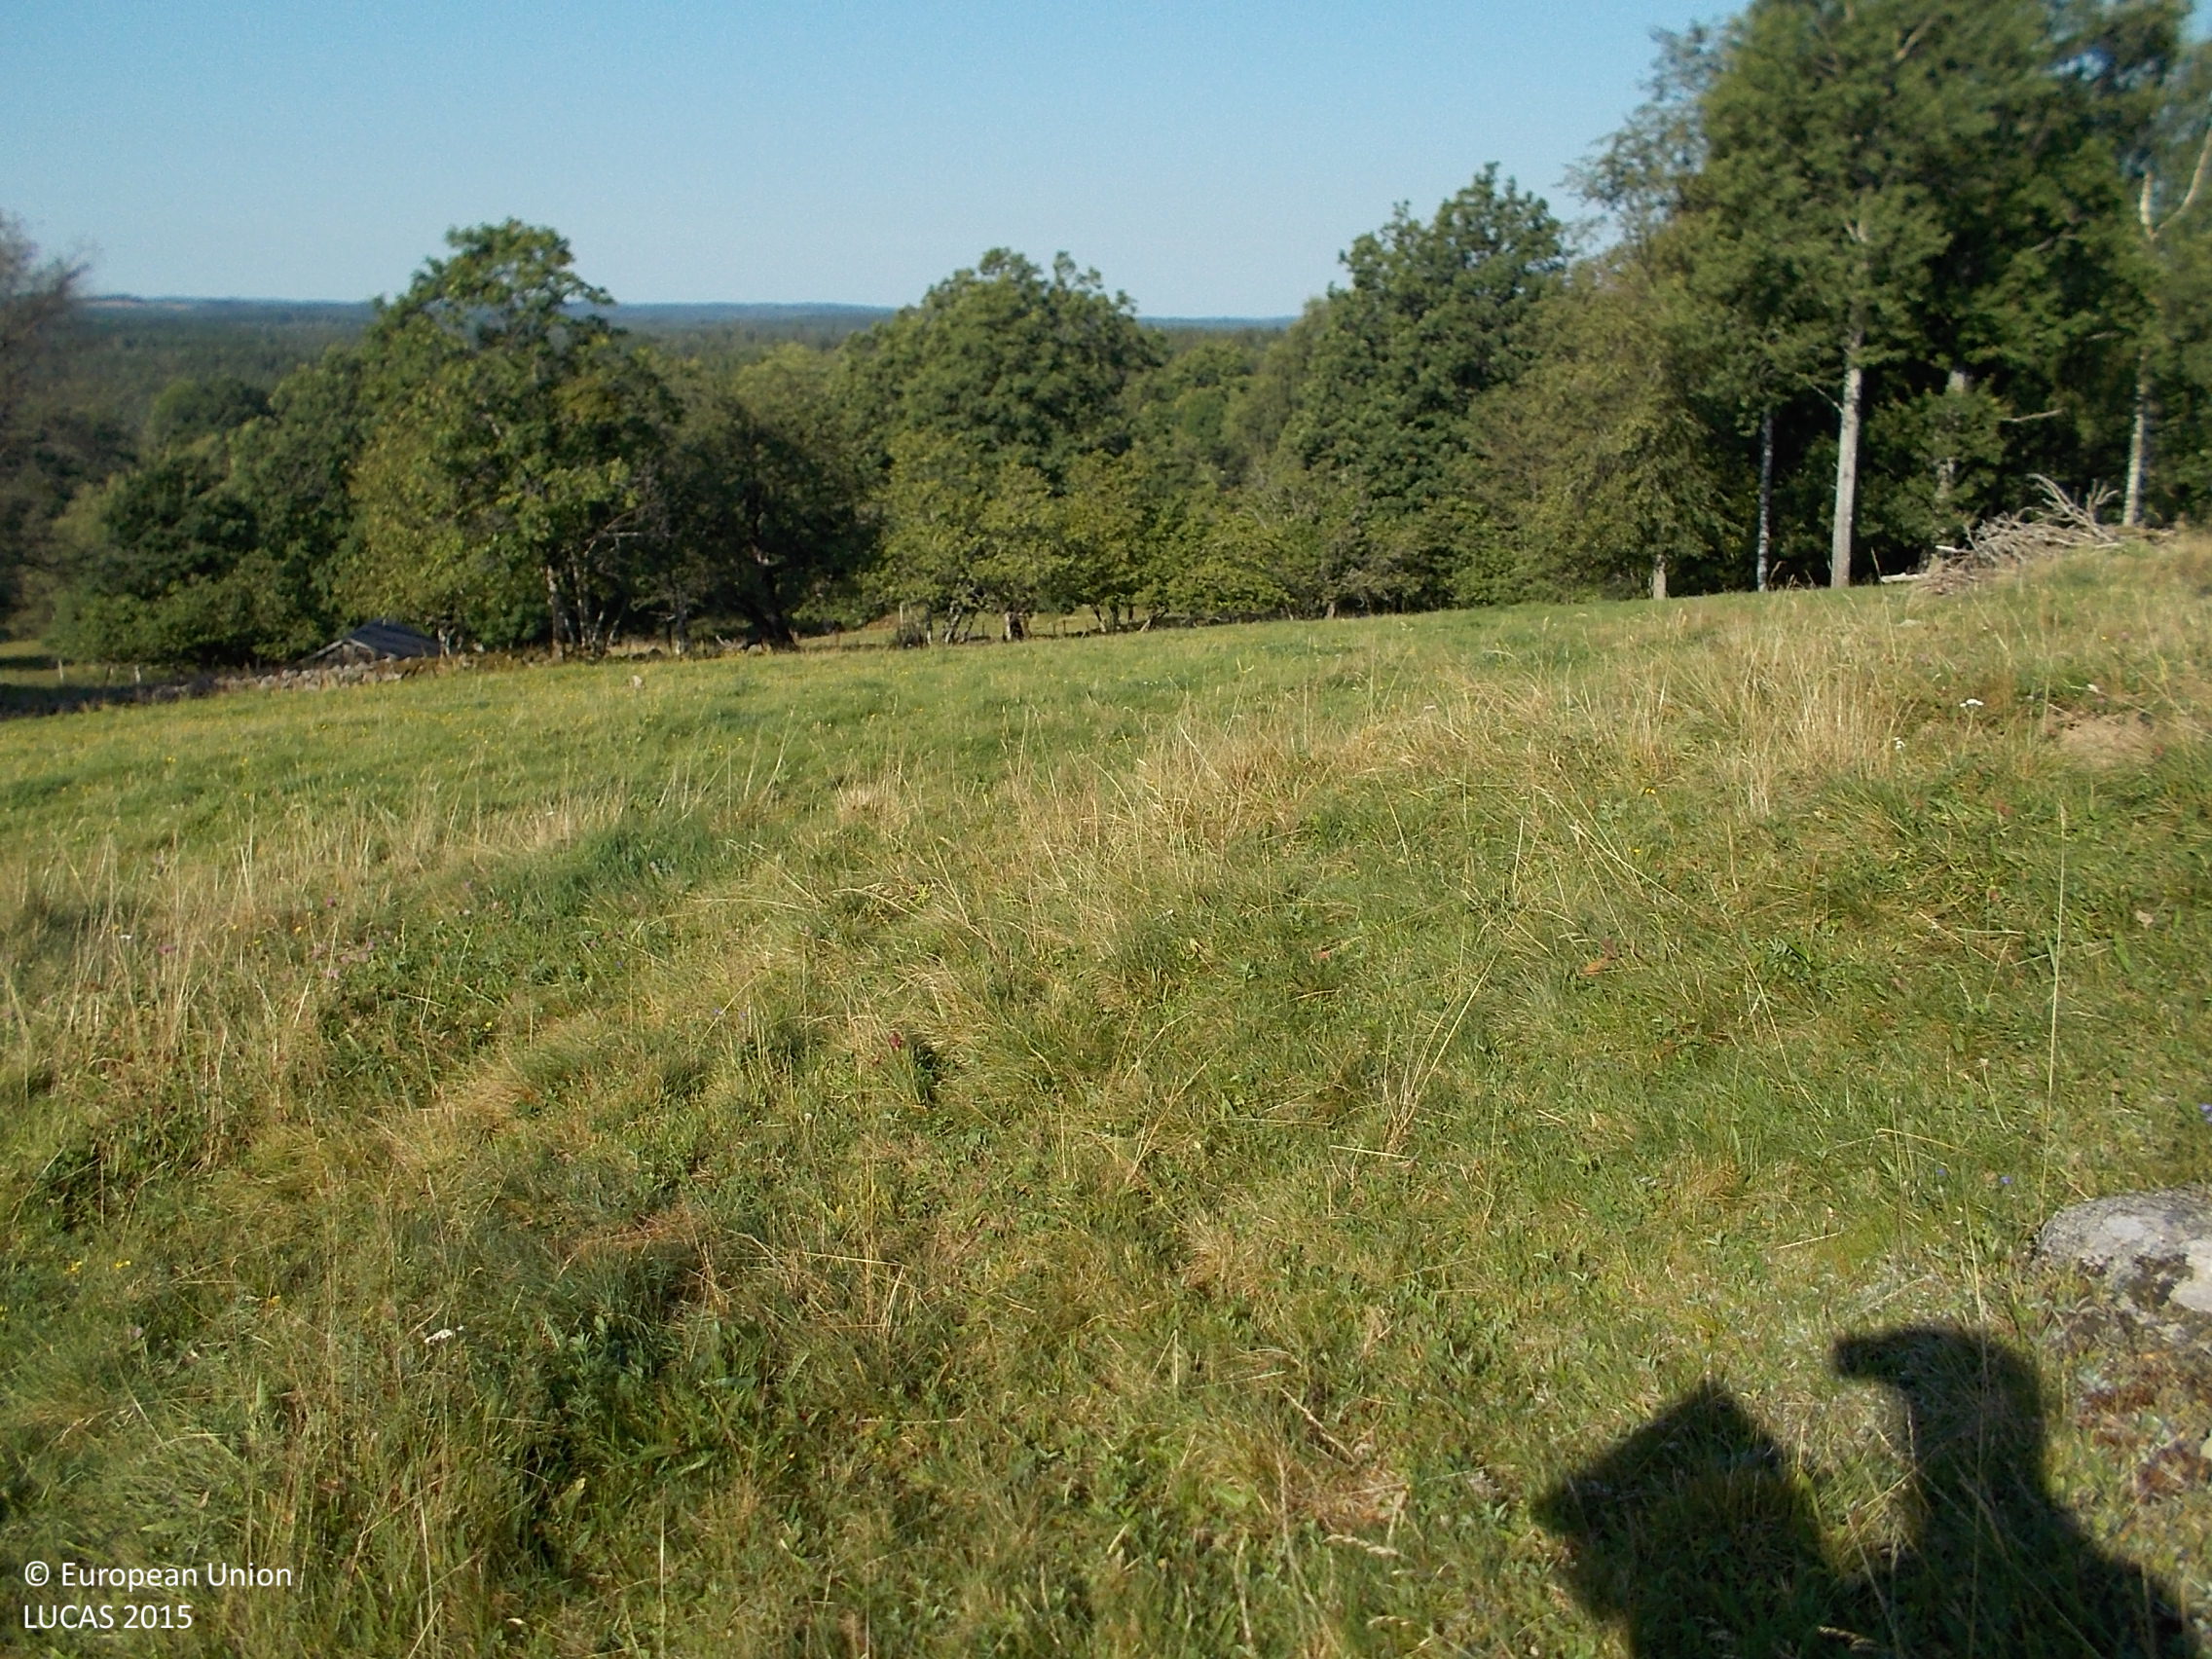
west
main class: Grassland
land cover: Grassland without tree/shrub cover
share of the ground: > 75 %
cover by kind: herbaceous plants 100 %
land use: Agriculture (excluding fallow land and kitchen gardens)
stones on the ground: < 10 %
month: August
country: SE
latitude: 57.4252
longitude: 13.2098
